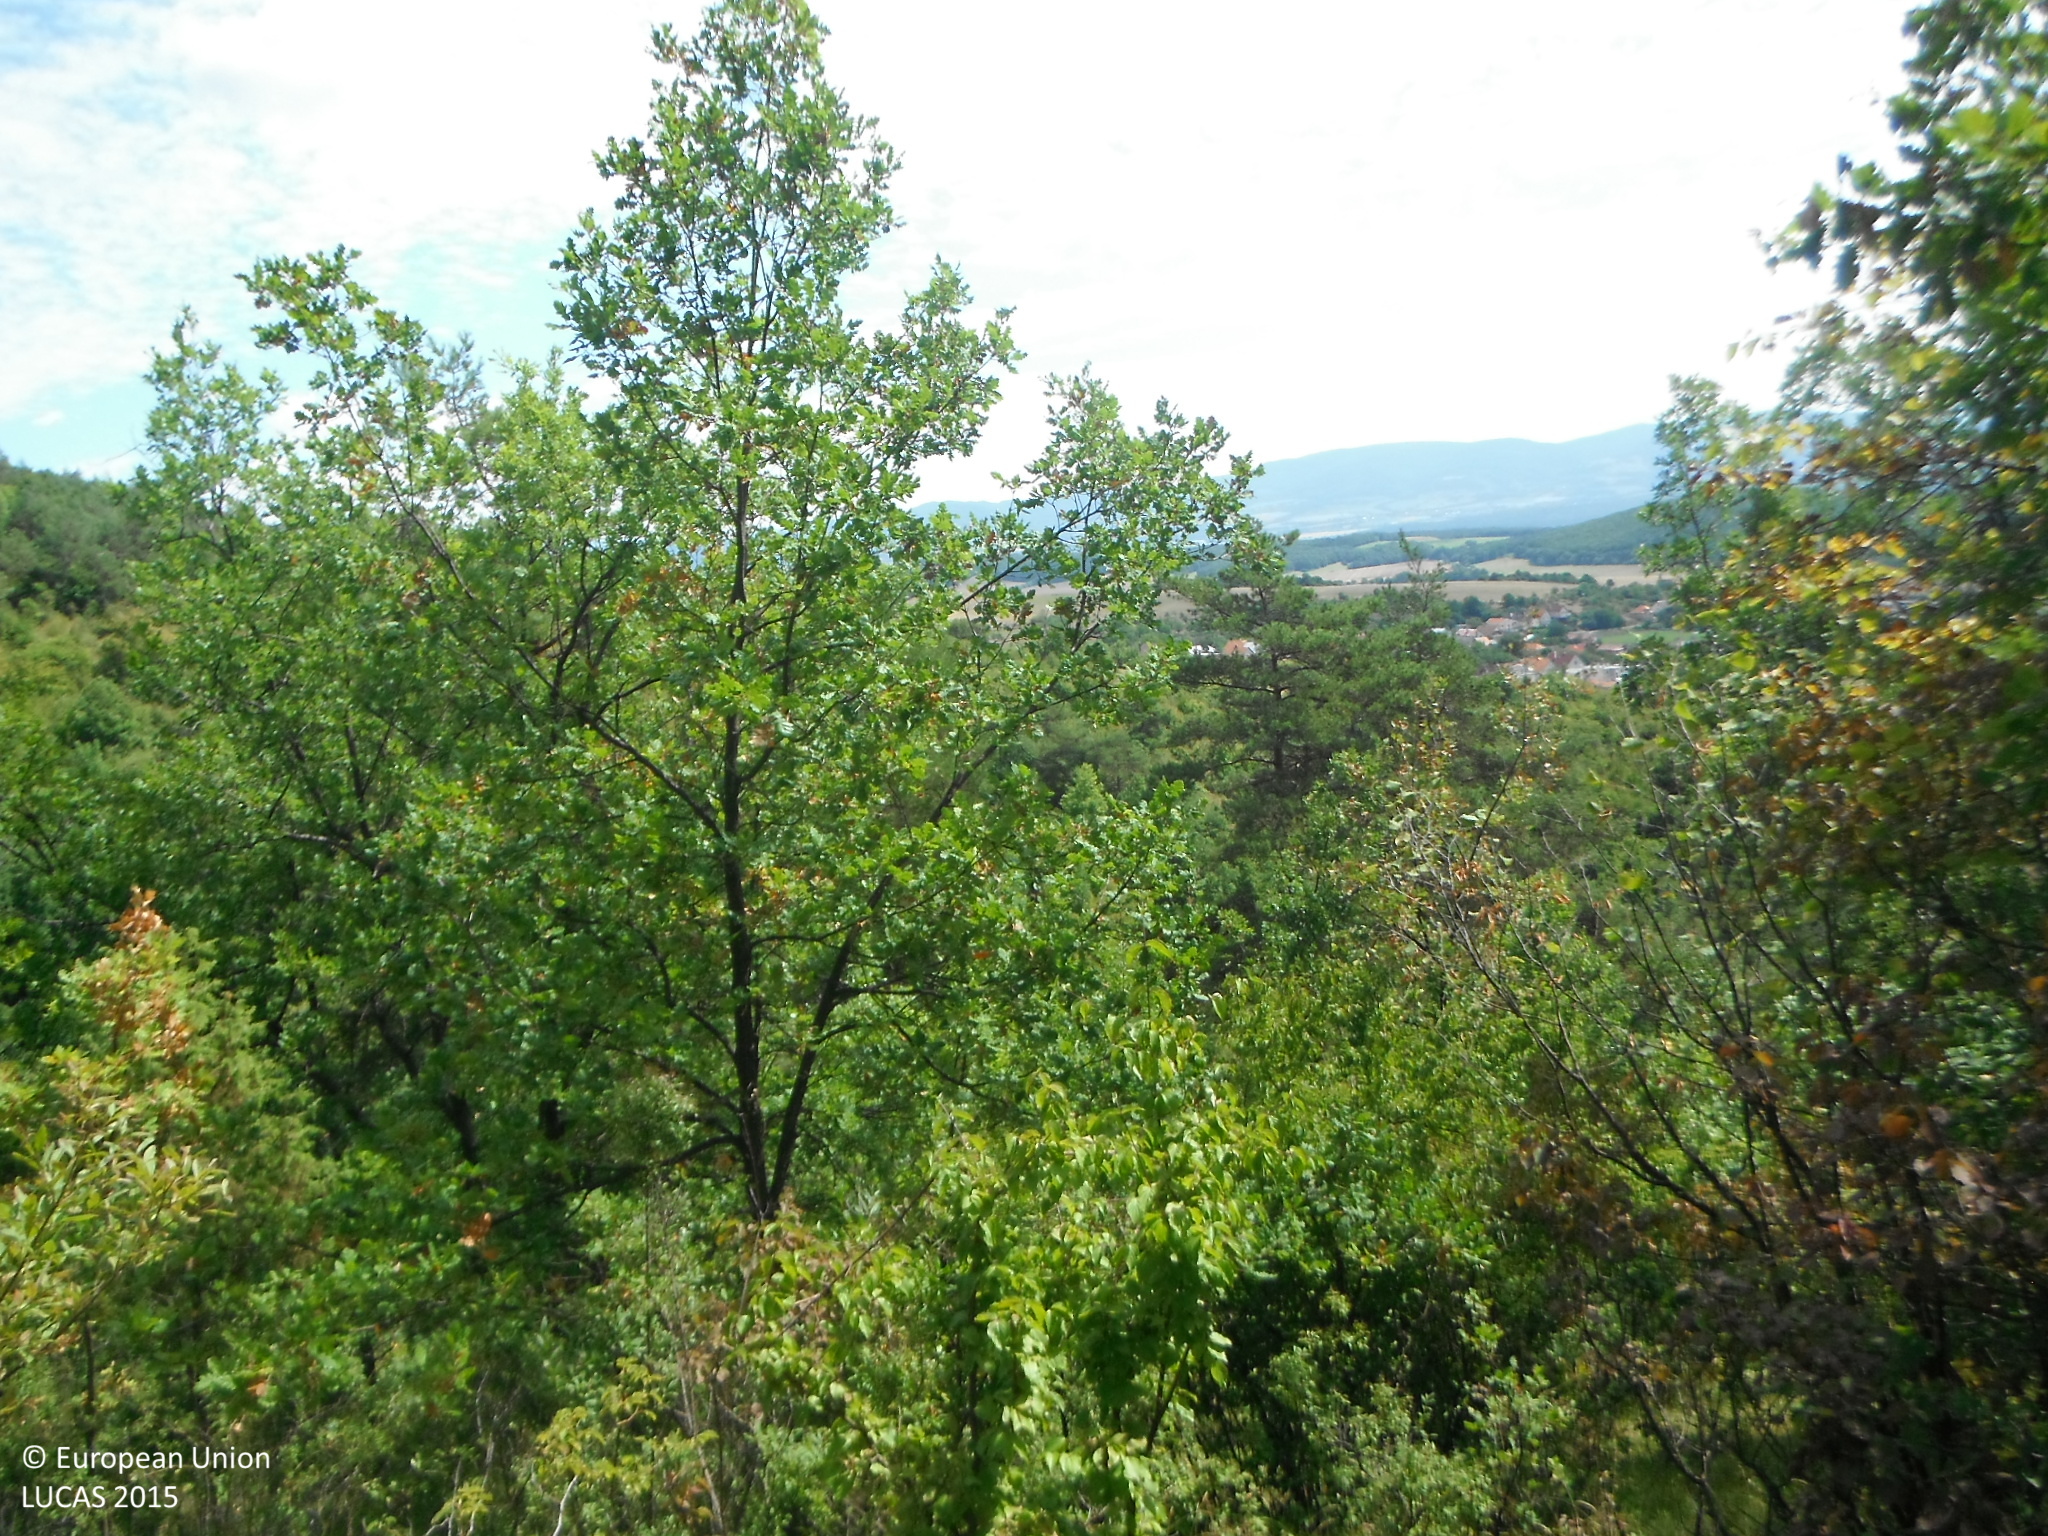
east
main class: Woodland
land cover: Broadleaved woodland
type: acidophilous oak and oak-birch forest
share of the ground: 50 - 75 %
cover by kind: broadleaved forest trees 60 %, shrubs 30 %, coniferous forest trees 5 %, herbaceous plants 5 %
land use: Forestry
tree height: > 5 m
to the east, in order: Broadleaved woodland; Tracks; Broadleaved woodland; Shrubland with sparse tree cover; Shrubland without tree cover
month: July
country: SK
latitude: 48.7301
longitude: 18.4598
